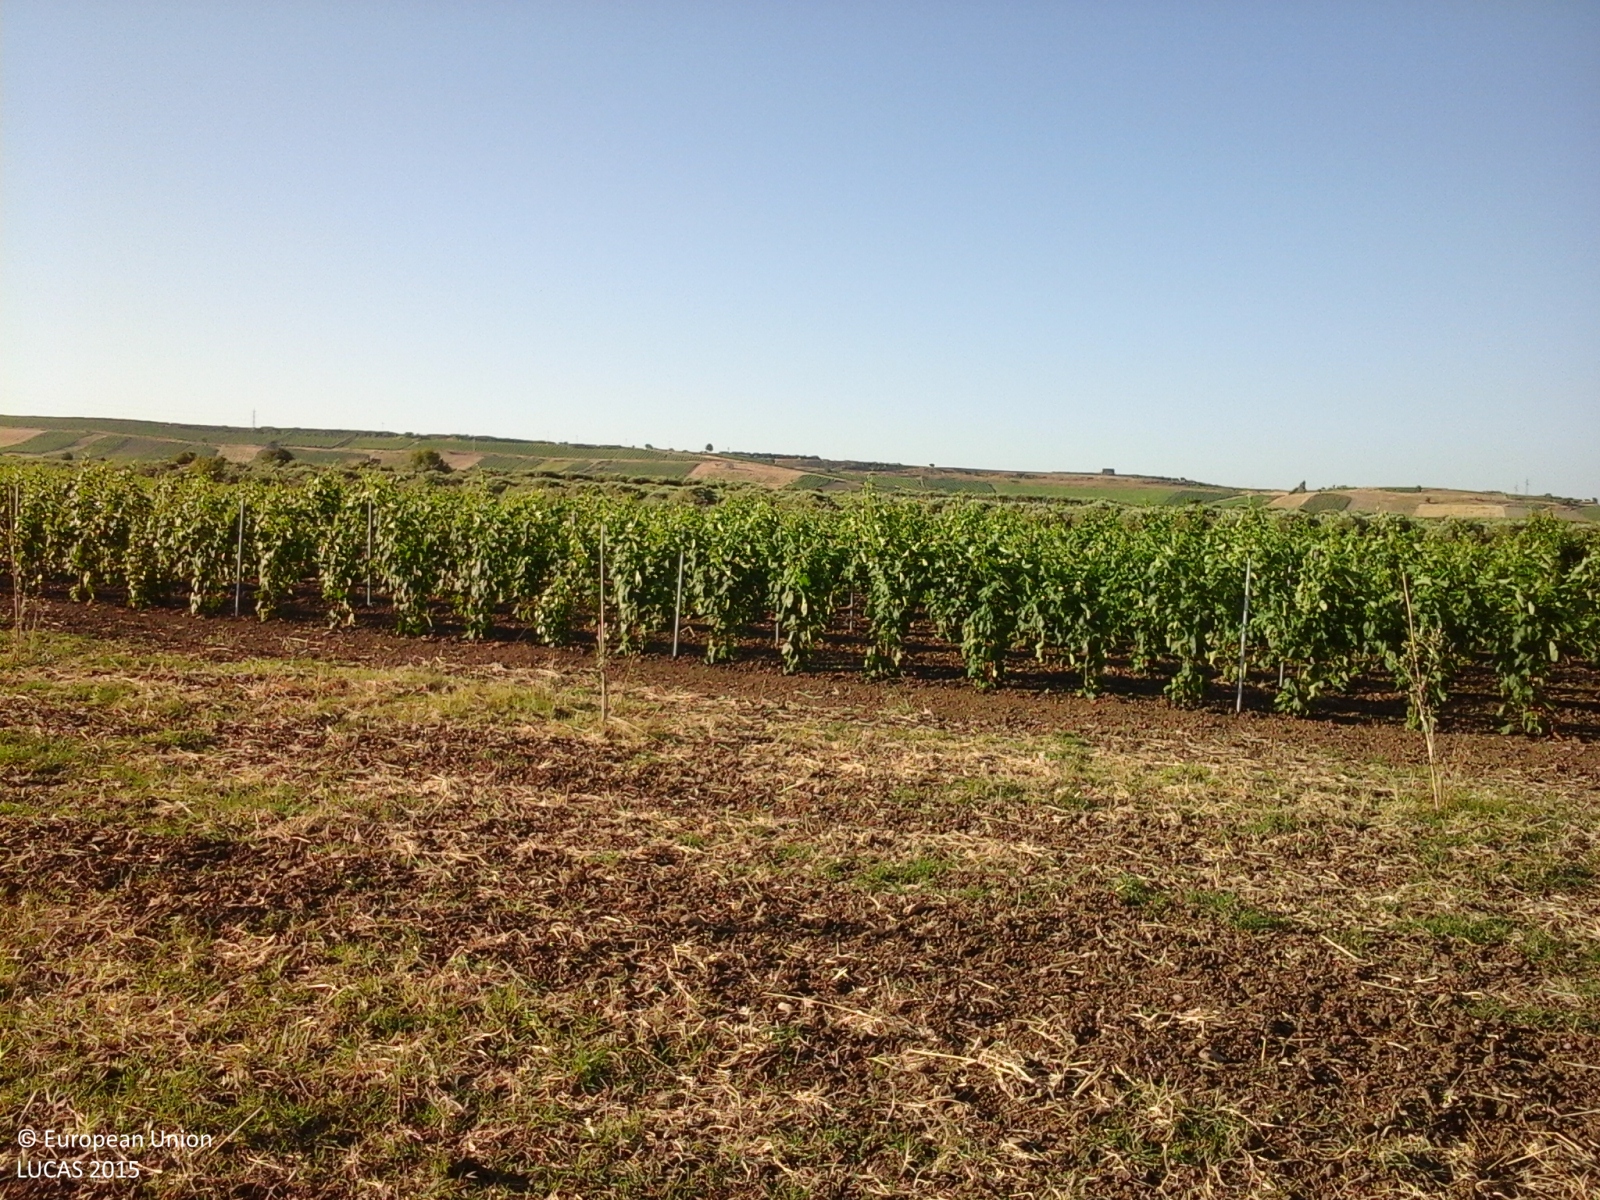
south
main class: Cropland
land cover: Olive groves
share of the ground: < 10 %
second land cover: Spontaneously vegetated surfaces
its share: < 10 %
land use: Agriculture (excluding fallow land and kitchen gardens)
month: June
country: IT
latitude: 37.7231
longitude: 12.8490
